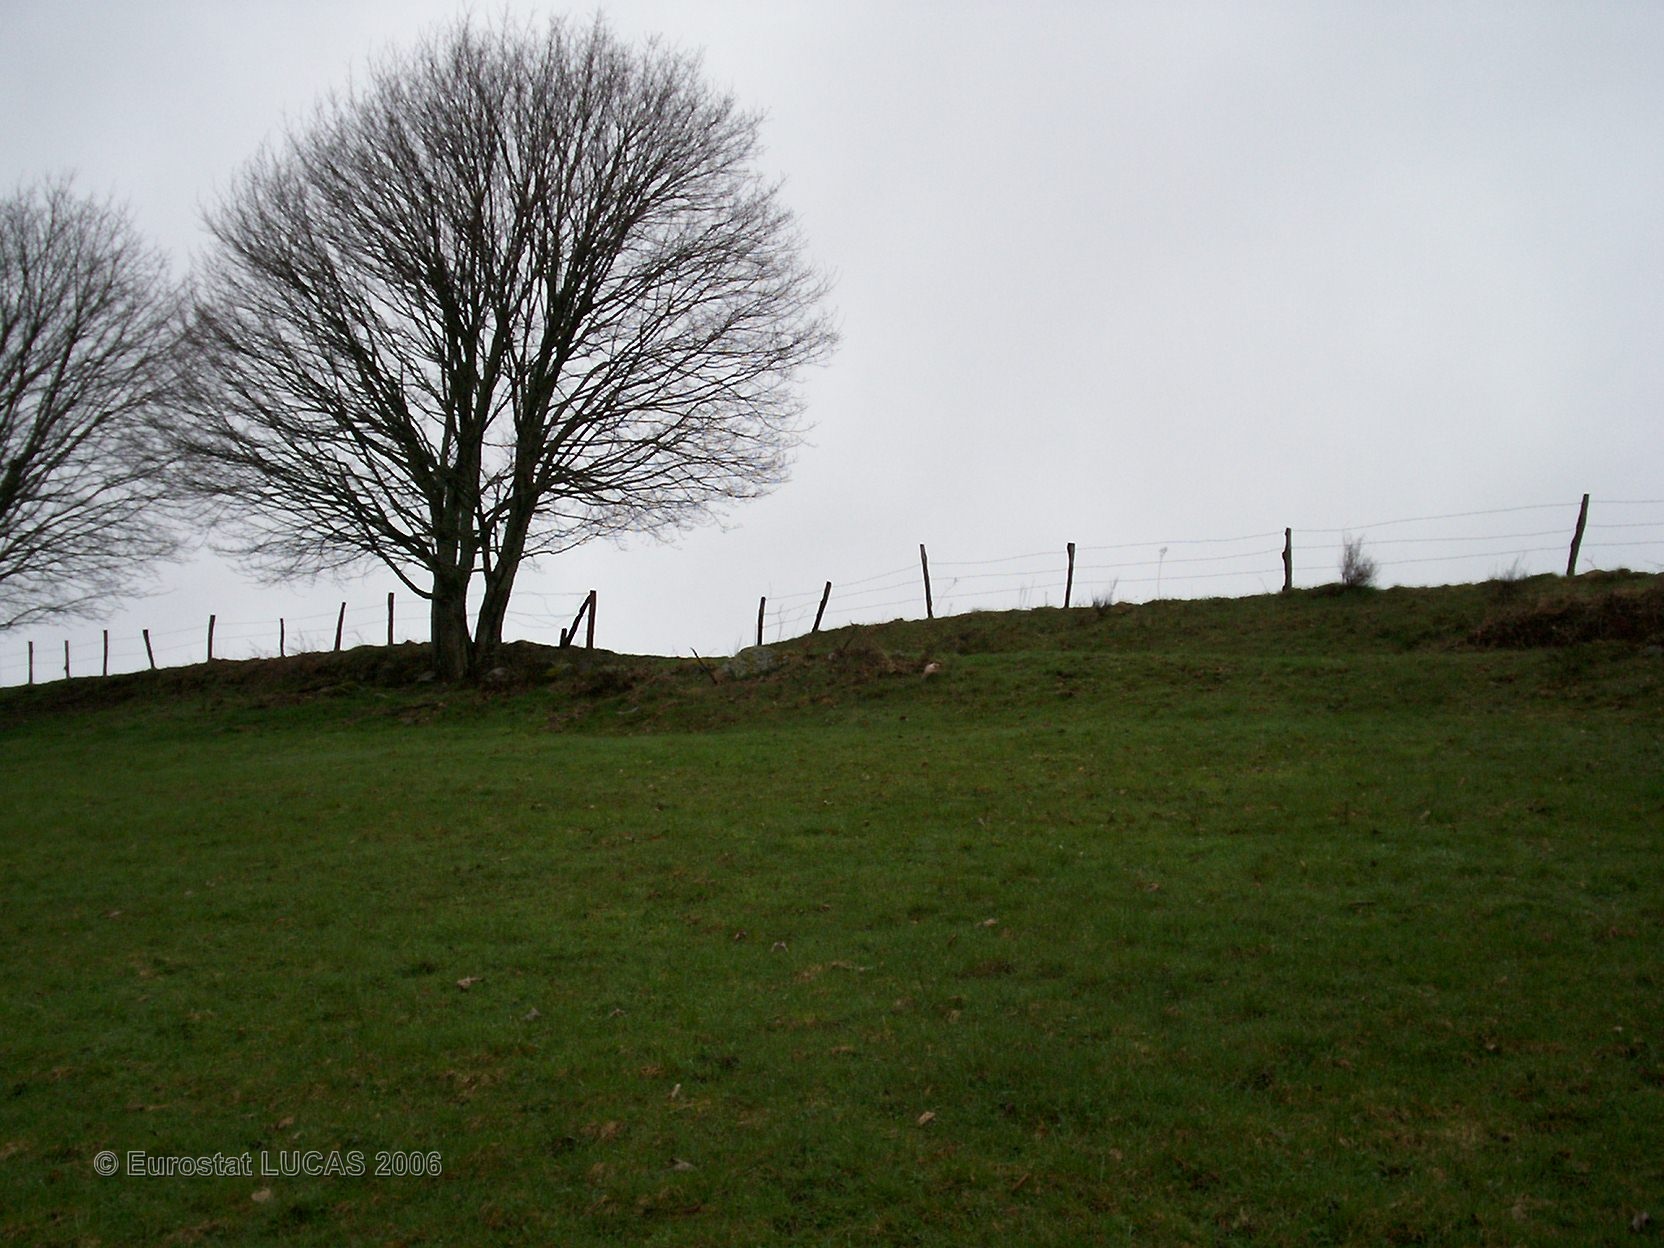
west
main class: Grassland
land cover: Grassland without tree/shrub cover
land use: Agriculture (excluding fallow land and kitchen gardens)
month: April
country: FR
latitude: 47.9358
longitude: 6.5609
